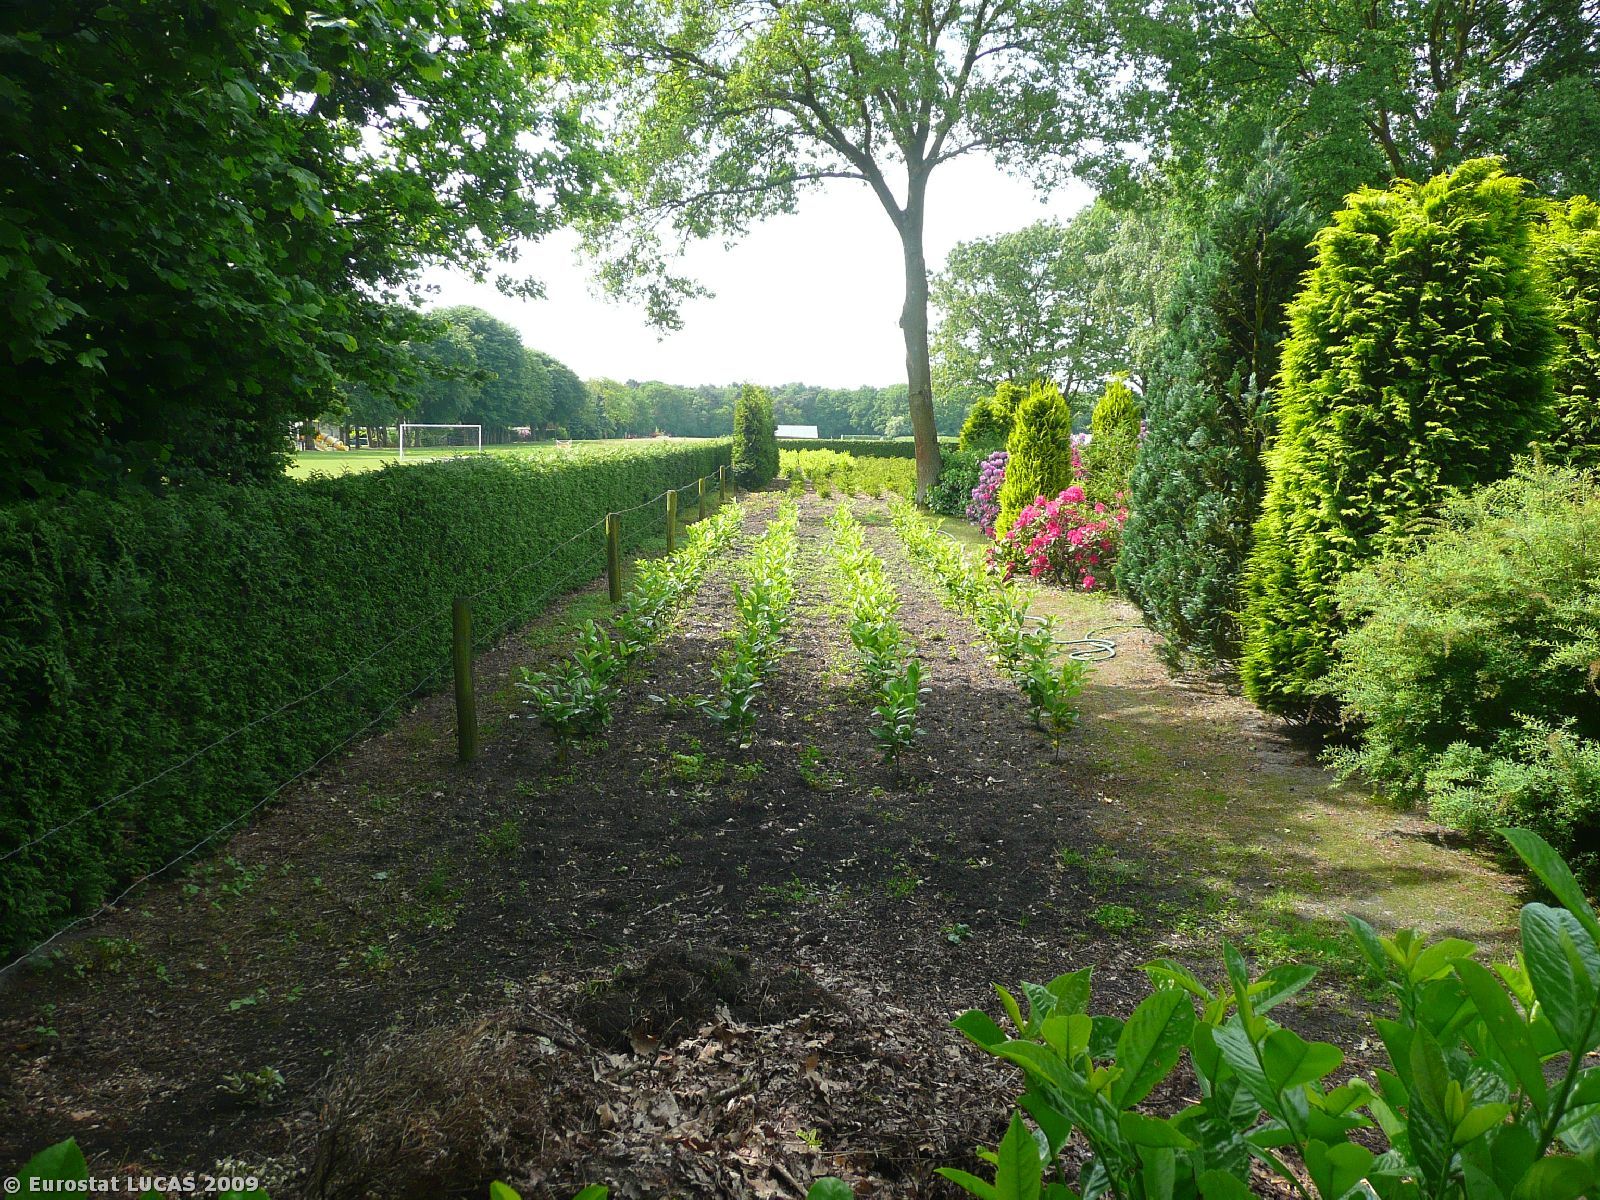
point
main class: Woodland
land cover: Coniferous woodland
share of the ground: > 75 %
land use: Residential
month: May
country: NL
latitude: 52.1598
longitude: 5.3349
